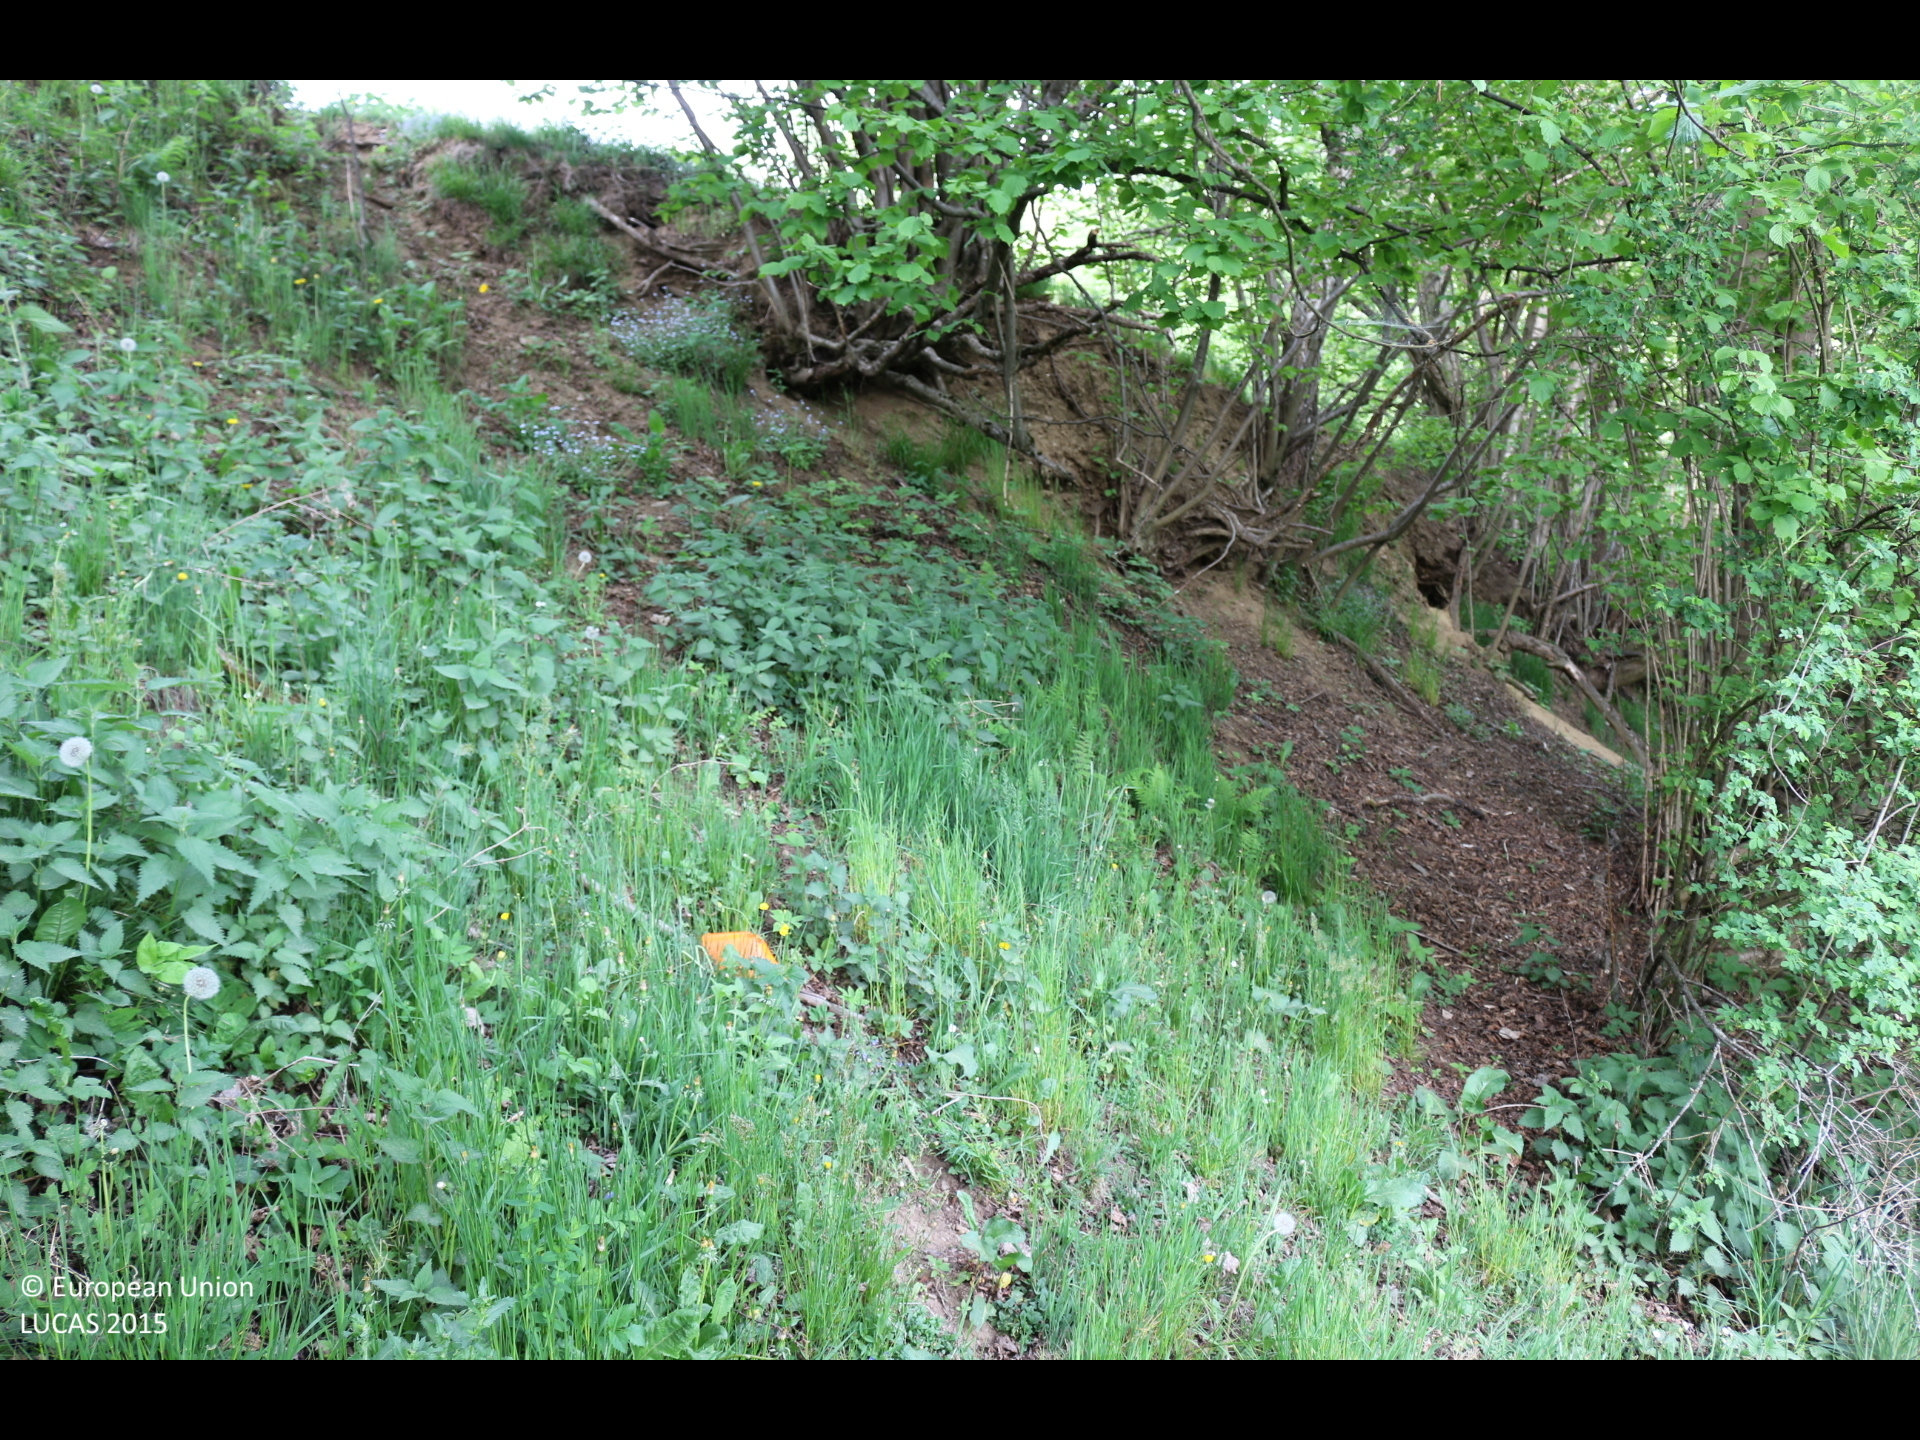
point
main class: Woodland
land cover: Broadleaved woodland
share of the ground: > 75 %
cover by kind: broadleaved forest trees 90 %, shrubs 5 %, herbaceous plants 5 %
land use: Forestry
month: May
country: AT
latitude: 46.7757
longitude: 14.1492
